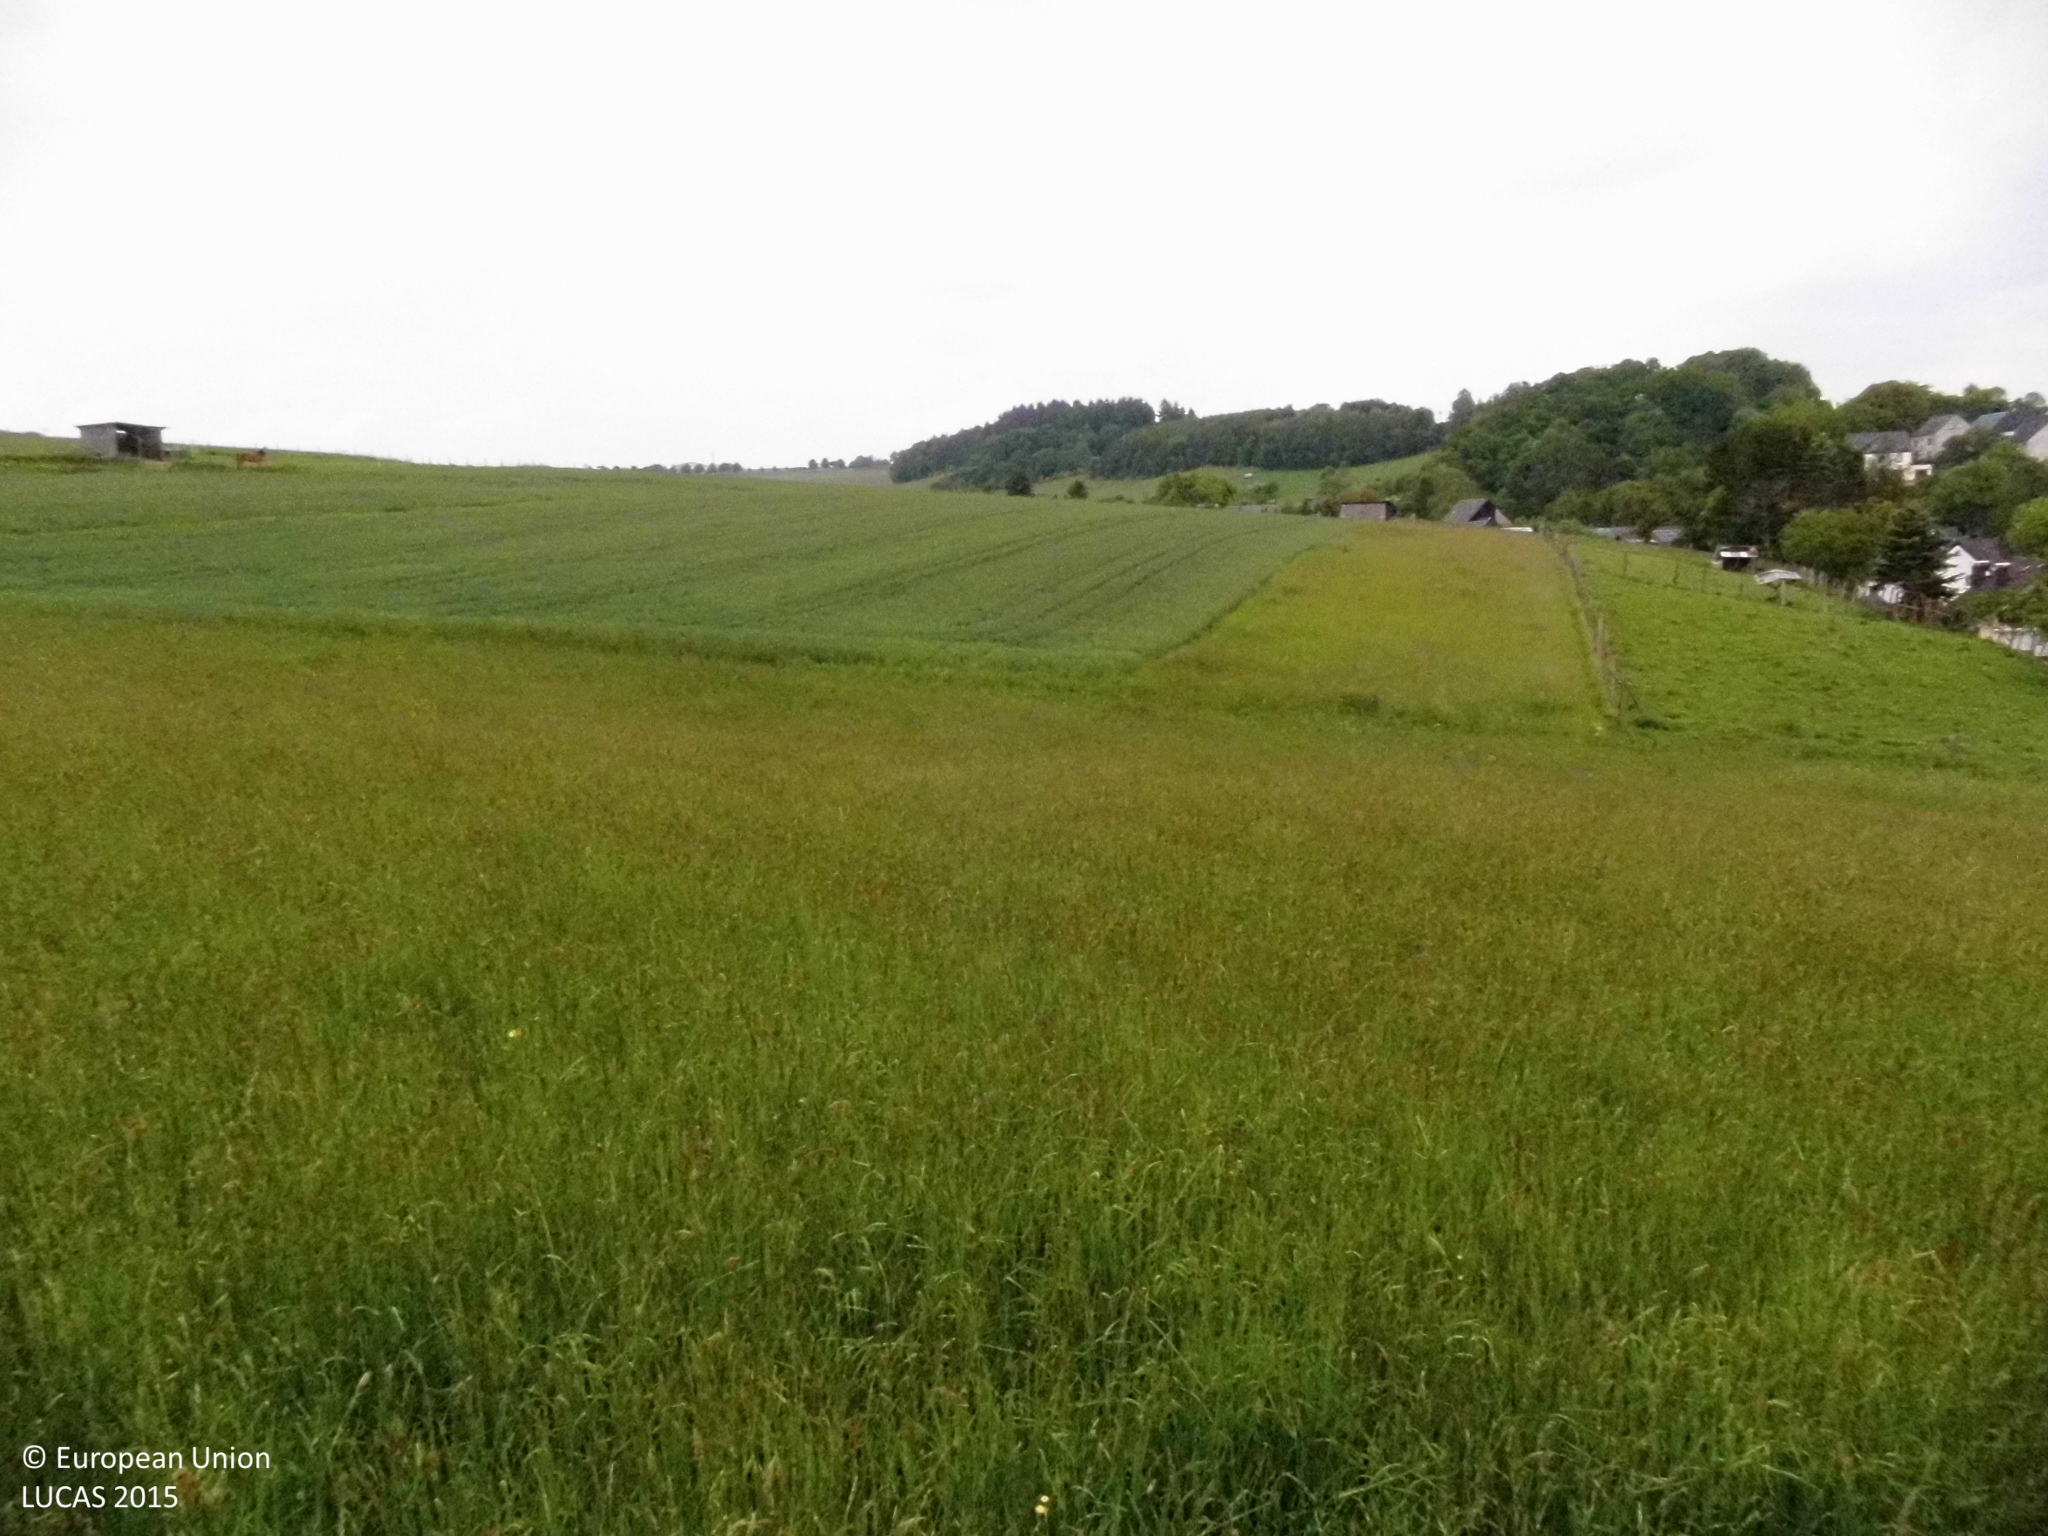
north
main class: Grassland
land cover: Grassland without tree/shrub cover
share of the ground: > 75 %
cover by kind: herbaceous plants 100 %
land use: Agriculture (excluding fallow land and kitchen gardens)
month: May
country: DE
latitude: 50.5353
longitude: 7.5312
